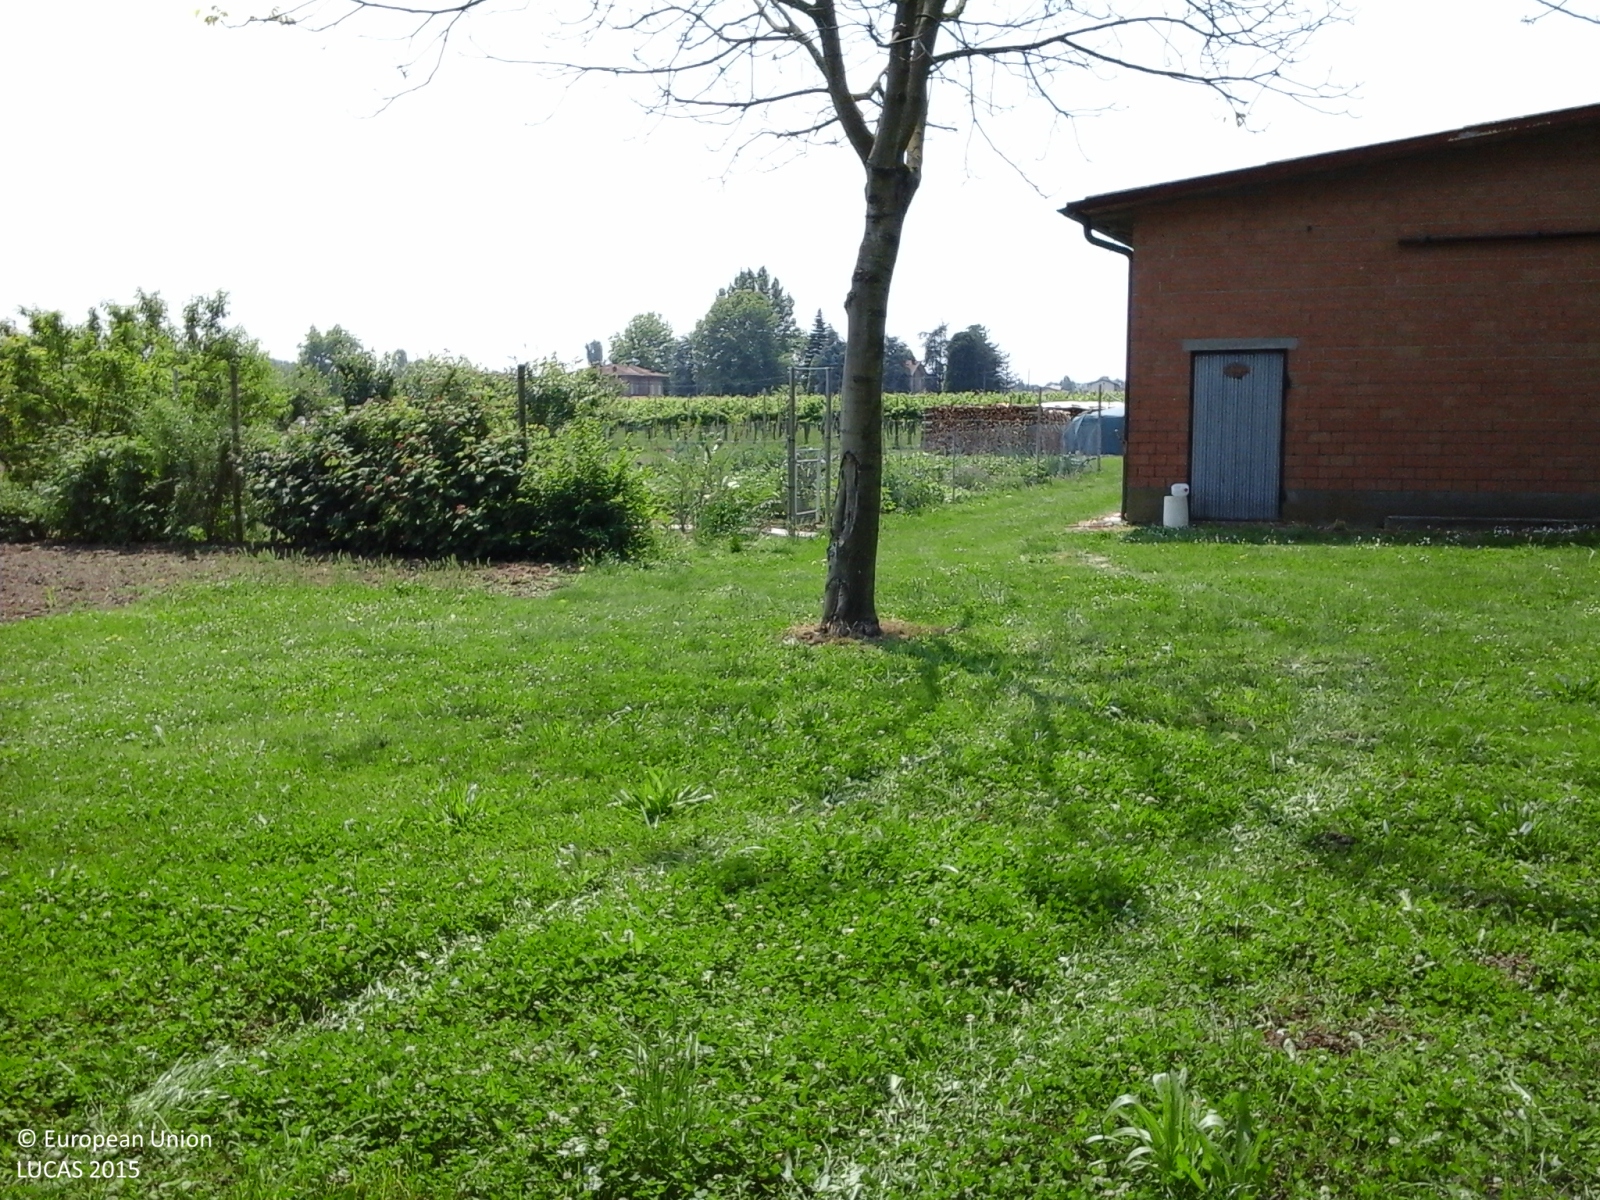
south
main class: Woodland
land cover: Broadleaved woodland
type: thermophilous deciduous forest
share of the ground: 50 - 75 %
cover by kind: herbaceous plants 85 %, broadleaved forest trees 15 %
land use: Residential
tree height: > 5 m
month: May
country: IT
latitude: 44.7803
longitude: 10.7945
